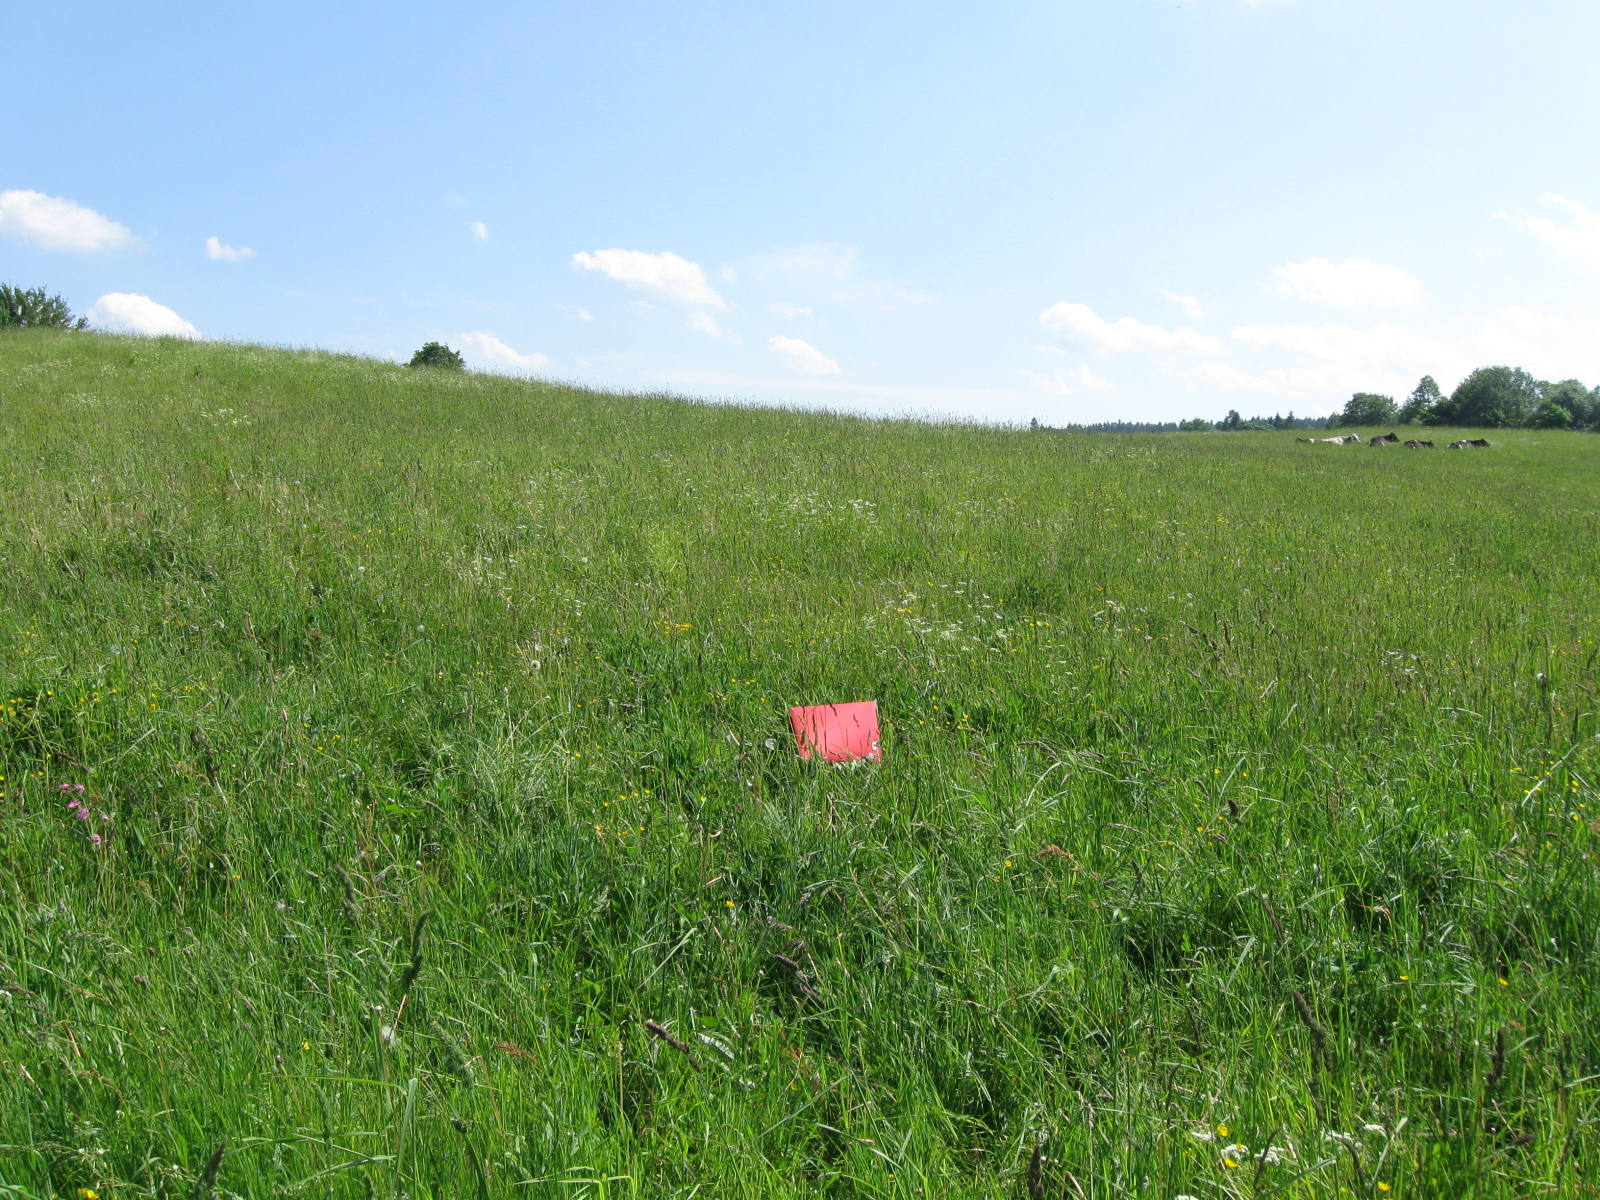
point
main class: Grassland
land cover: Grassland without tree/shrub cover
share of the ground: > 75 %
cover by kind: herbaceous plants 100 %
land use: Agriculture (excluding fallow land and kitchen gardens)
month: June
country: LT
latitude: 54.2540
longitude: 23.7639
